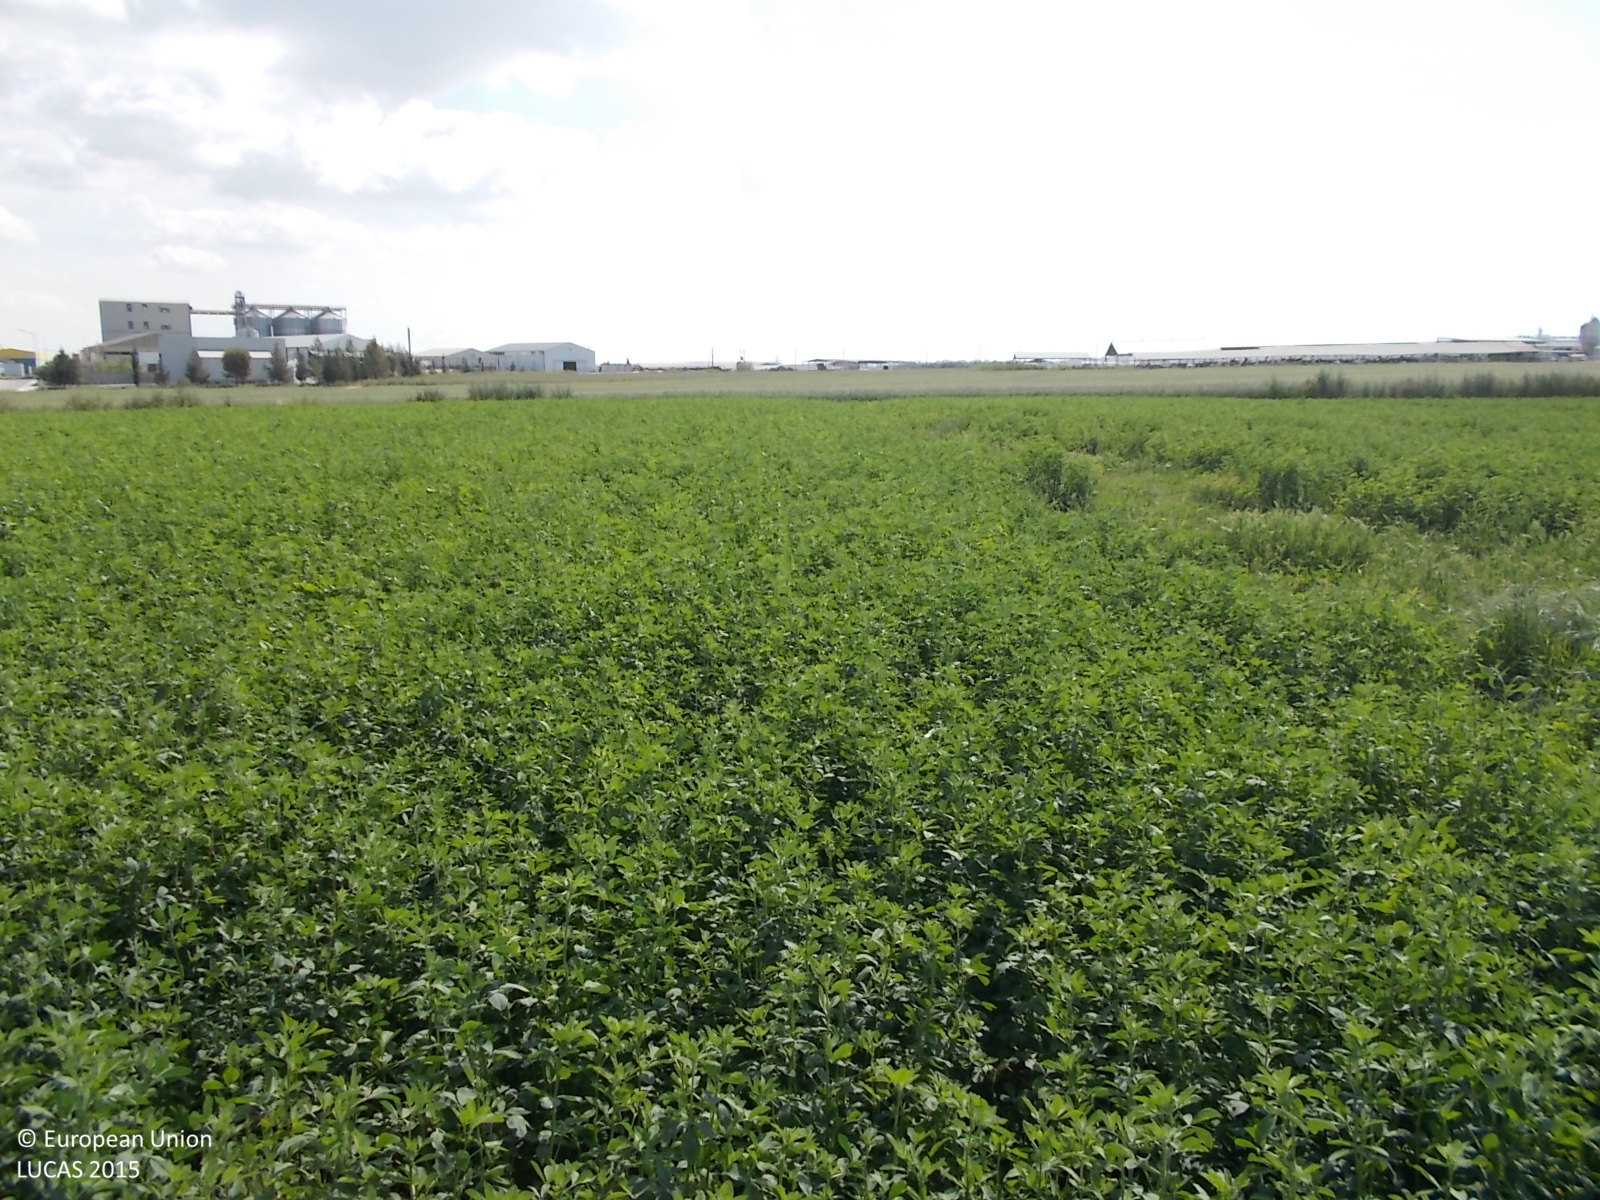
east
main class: Cropland
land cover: Lucerne
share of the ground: > 75 %
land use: Agriculture (excluding fallow land and kitchen gardens)
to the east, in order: Lucerne; Common wheat; Abandoned hedges; Paved roads, cycling and walking lanes; Abandoned hedges; Common wheat
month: April
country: CY
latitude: 35.0544
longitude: 33.5170
